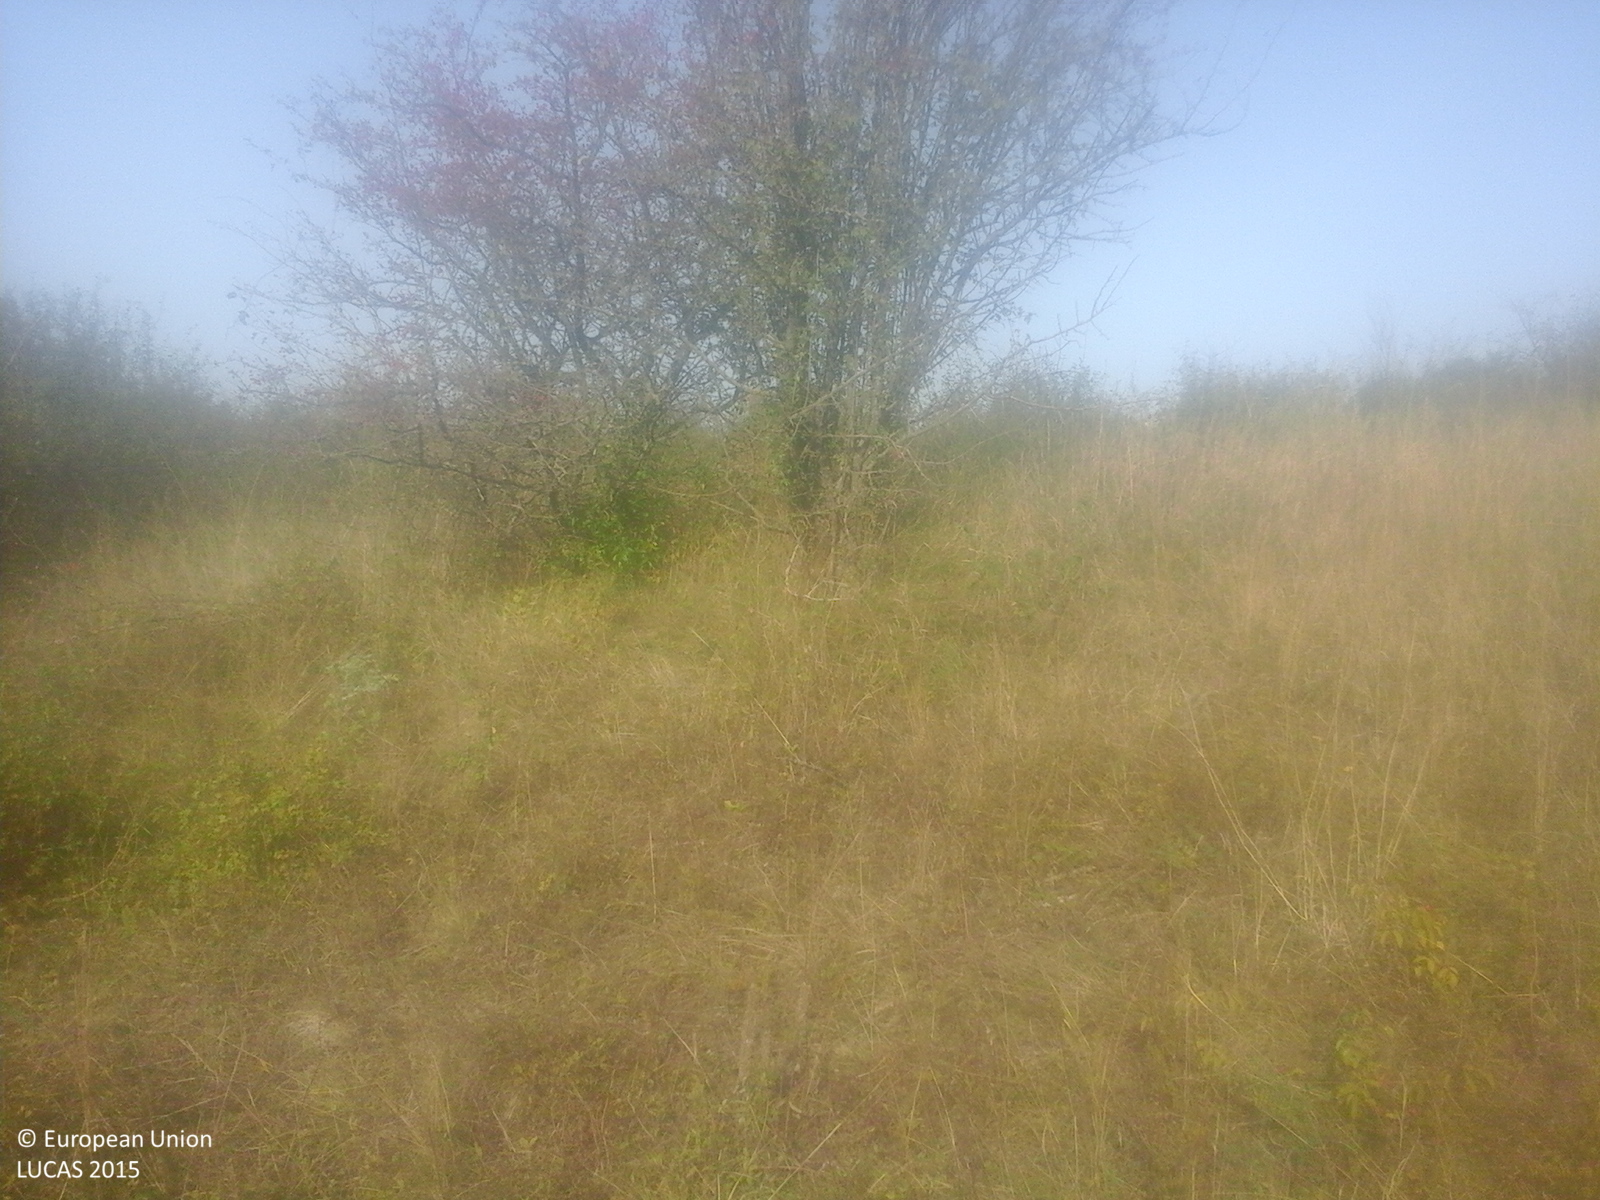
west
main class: Grassland
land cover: Grassland with sparse tree/shrub cover
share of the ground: > 75 %
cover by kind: herbaceous plants 85 %, shrubs 10 %, broadleaved forest trees 5 %
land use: Agriculture (excluding fallow land and kitchen gardens)
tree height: < 5 m
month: September
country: RO
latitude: 47.0349
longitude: 24.2584
